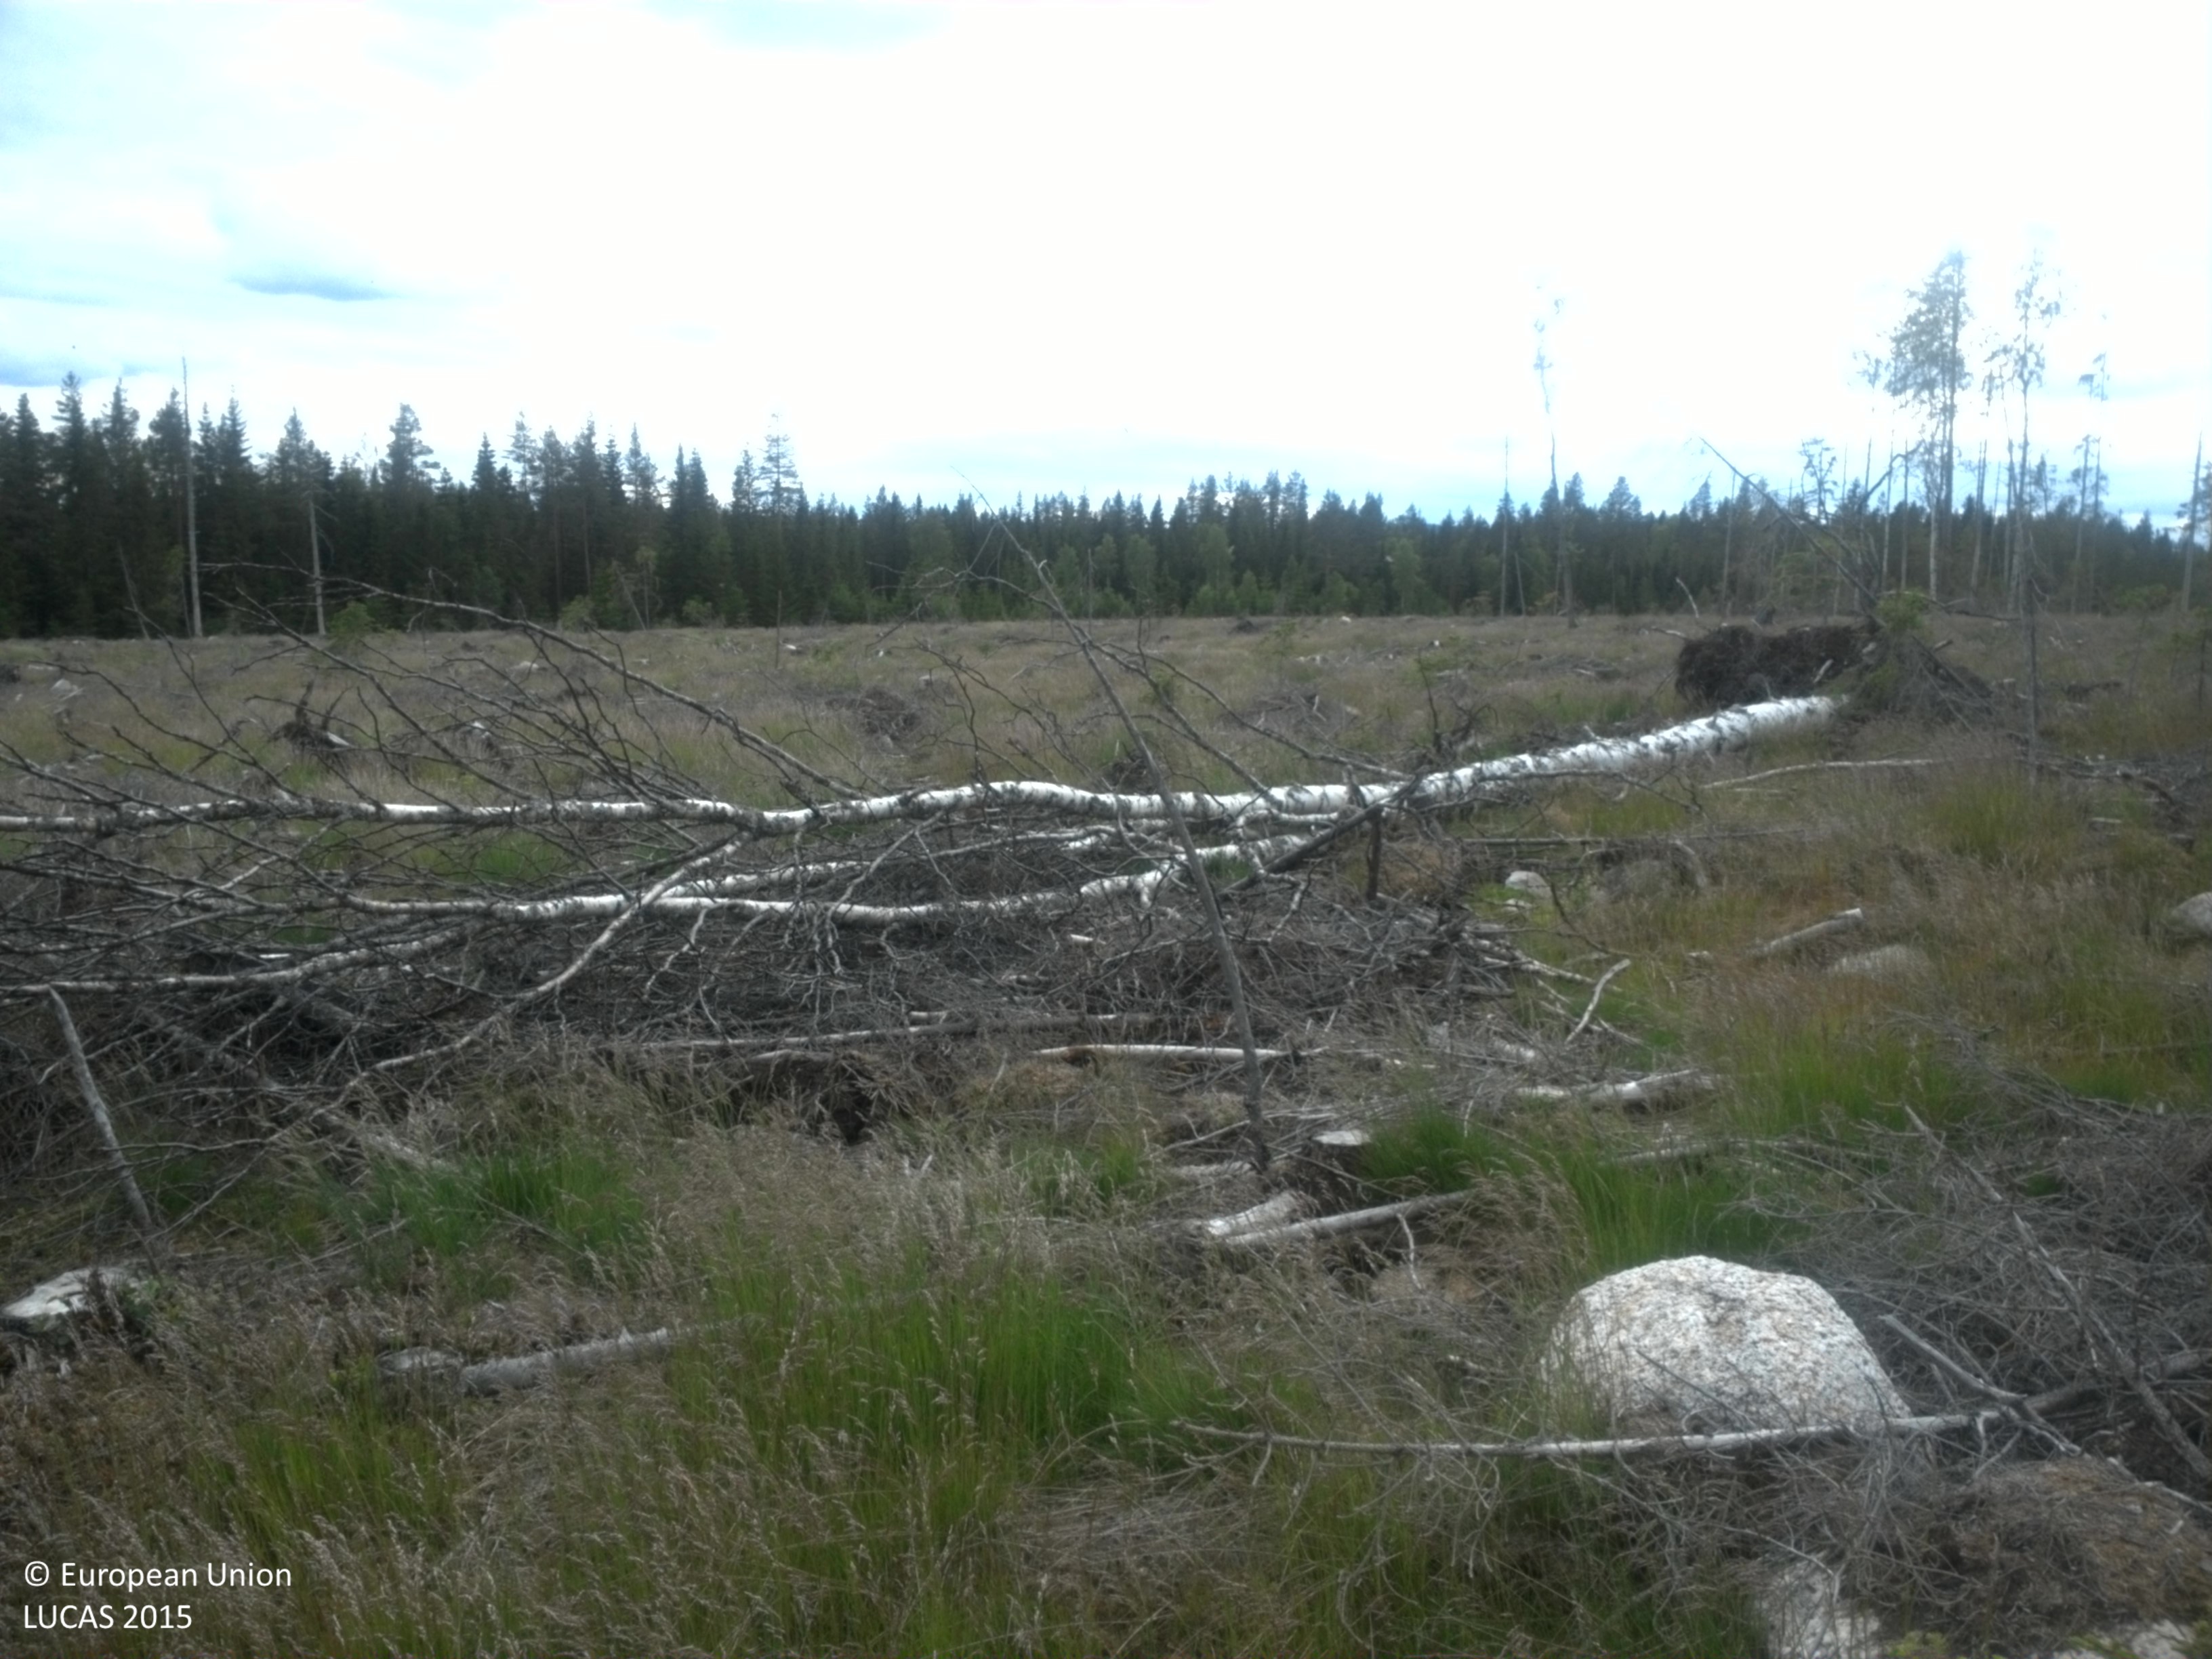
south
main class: Grassland
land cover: Grassland with sparse tree/shrub cover
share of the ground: > 75 %
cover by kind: herbaceous plants 65 %, unconsolidated bare surface 20 %, broadleaved forest trees 5 %, shrubs 5 %, consolidated bare surface 5 %
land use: Forestry
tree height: > 5 m
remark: Clear cut
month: July
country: SE
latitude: 64.6975
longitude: 20.3544
